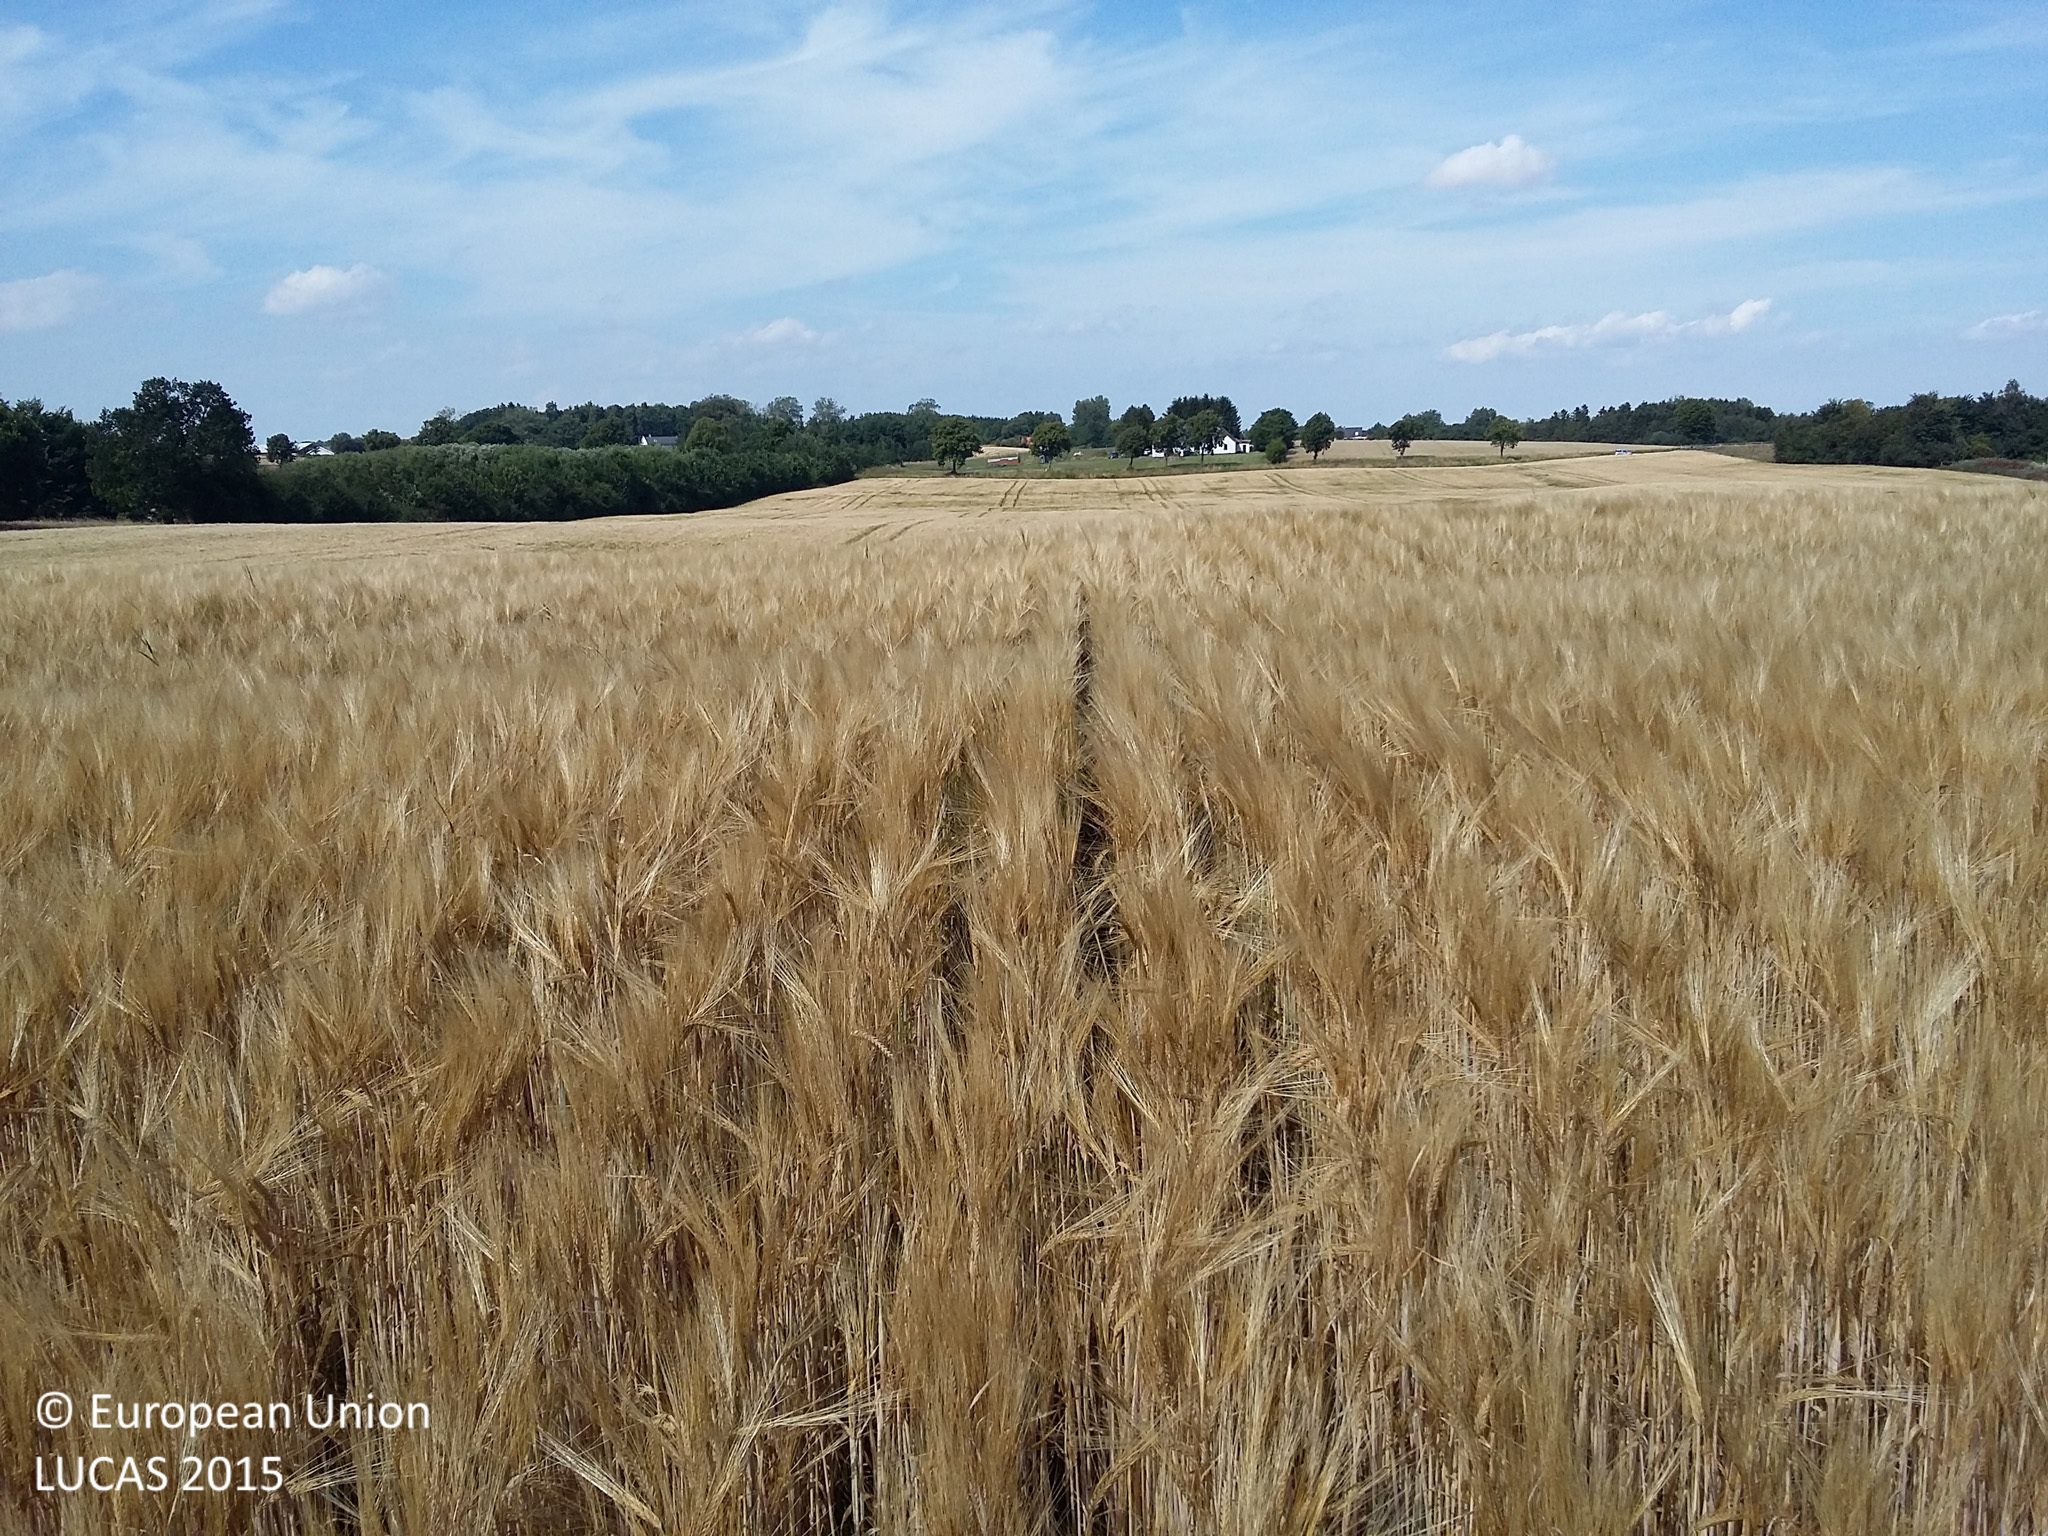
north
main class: Cropland
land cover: Barley
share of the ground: > 75 %
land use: Agriculture (excluding fallow land and kitchen gardens)
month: August
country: DK
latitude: 55.3484
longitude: 11.7806
